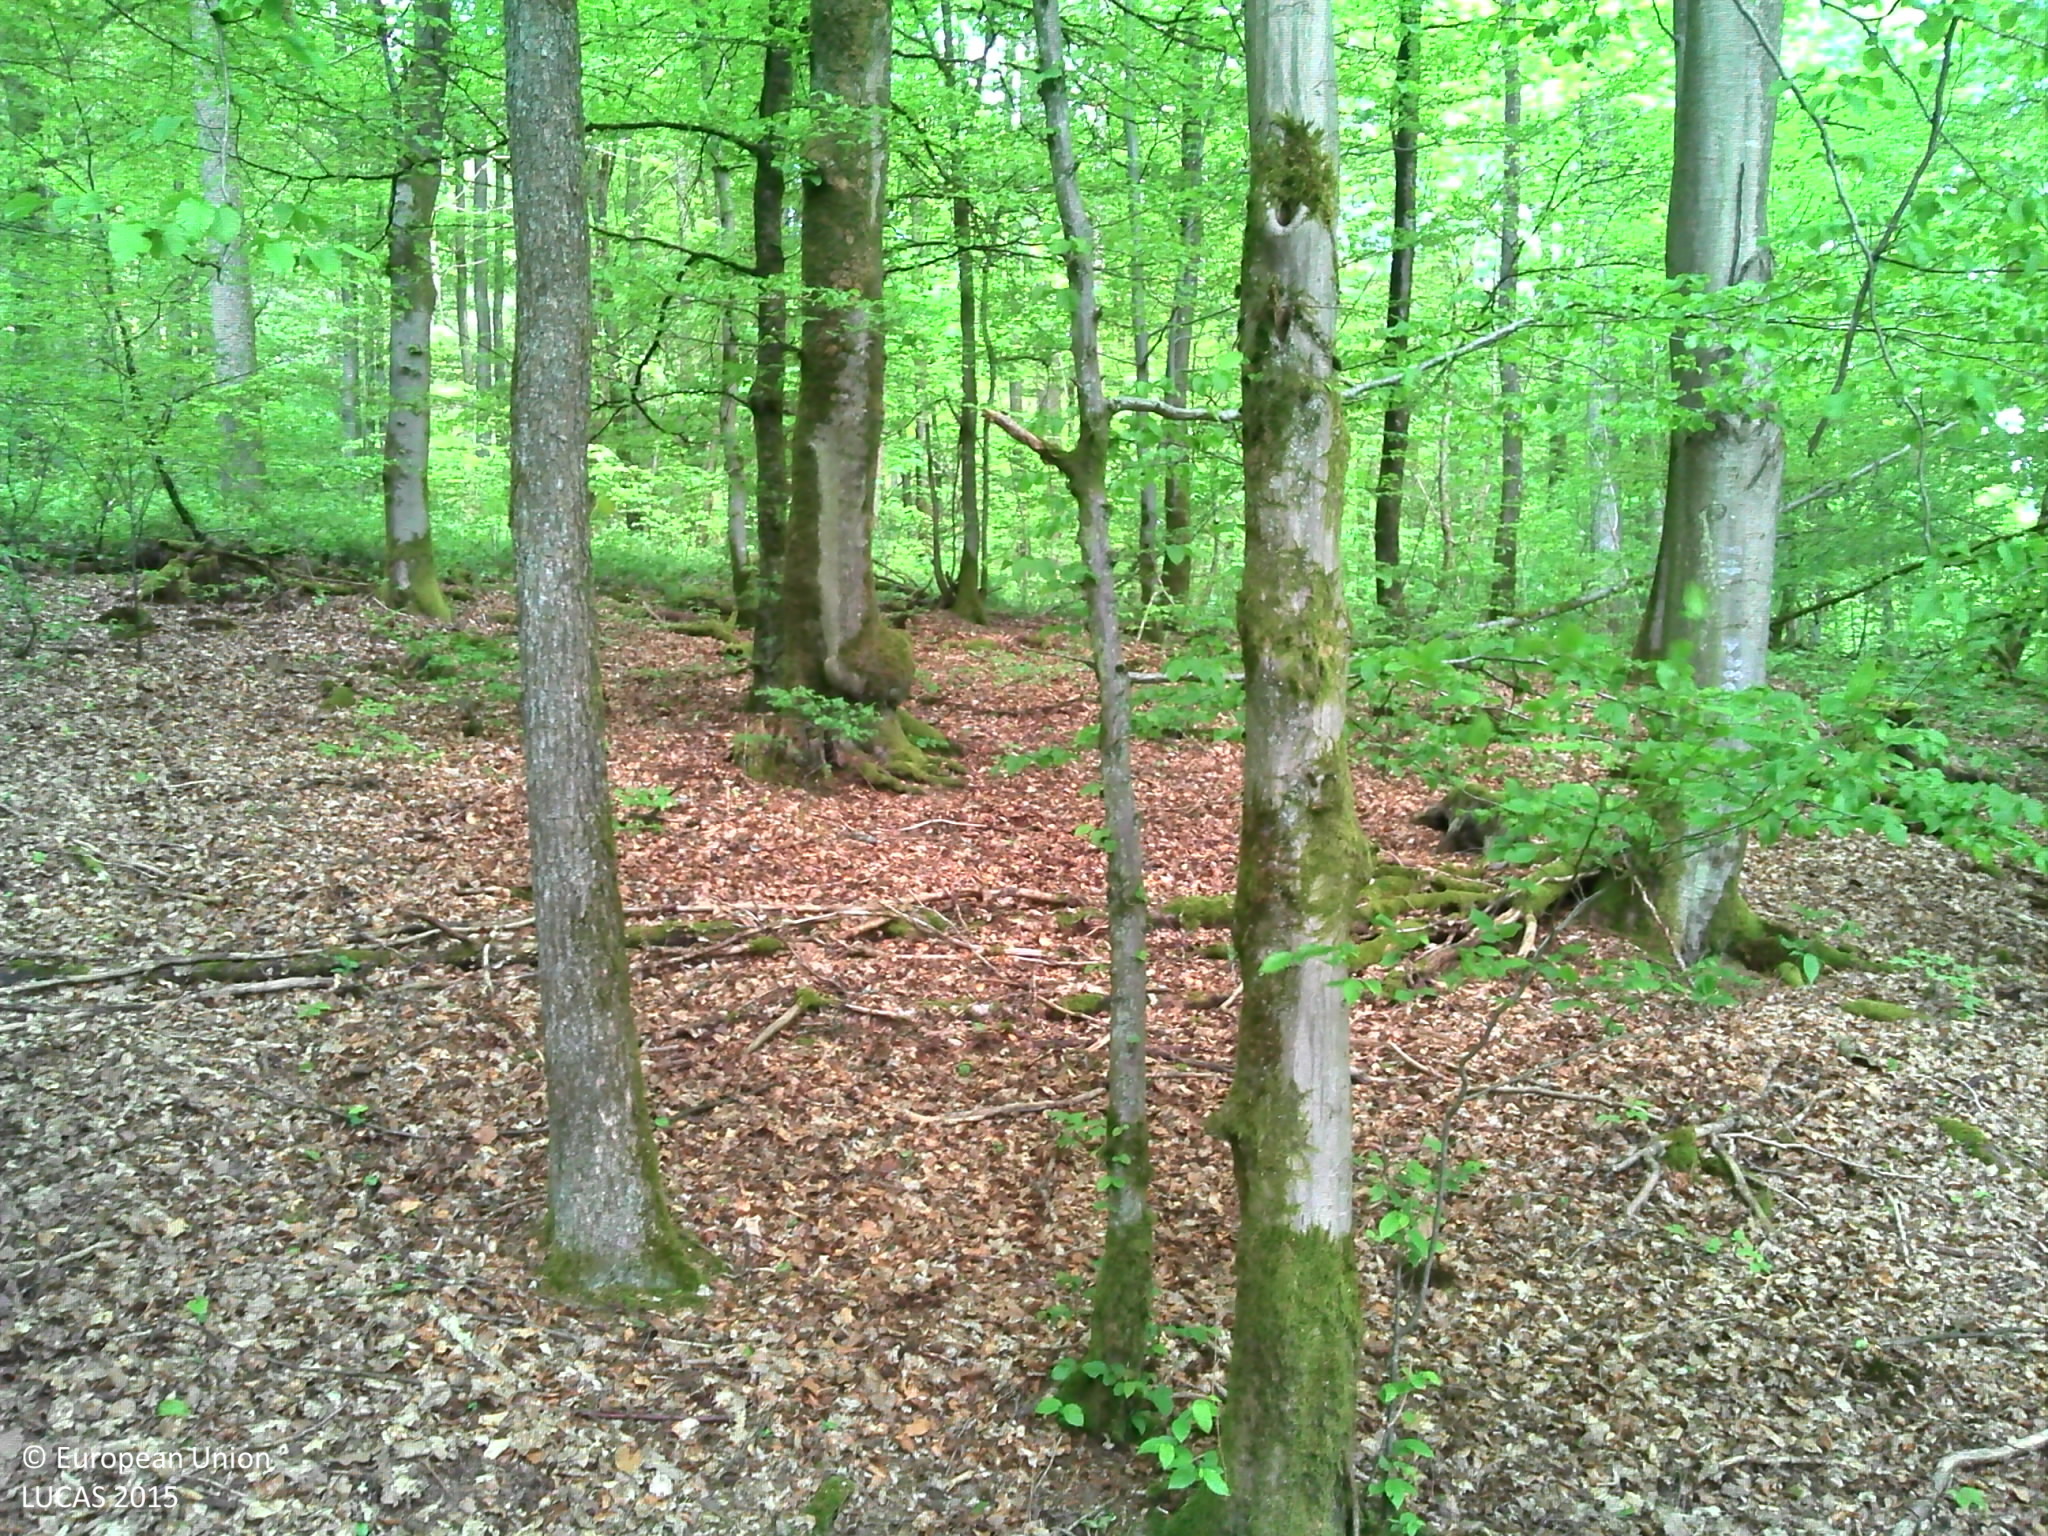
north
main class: Woodland
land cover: Broadleaved woodland
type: beech forest
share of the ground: > 75 %
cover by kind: broadleaved forest trees 90 %, lichens and mosses 10 %
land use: Forestry
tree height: > 5 m
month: May
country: LU
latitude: 49.9830
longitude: 5.8569
